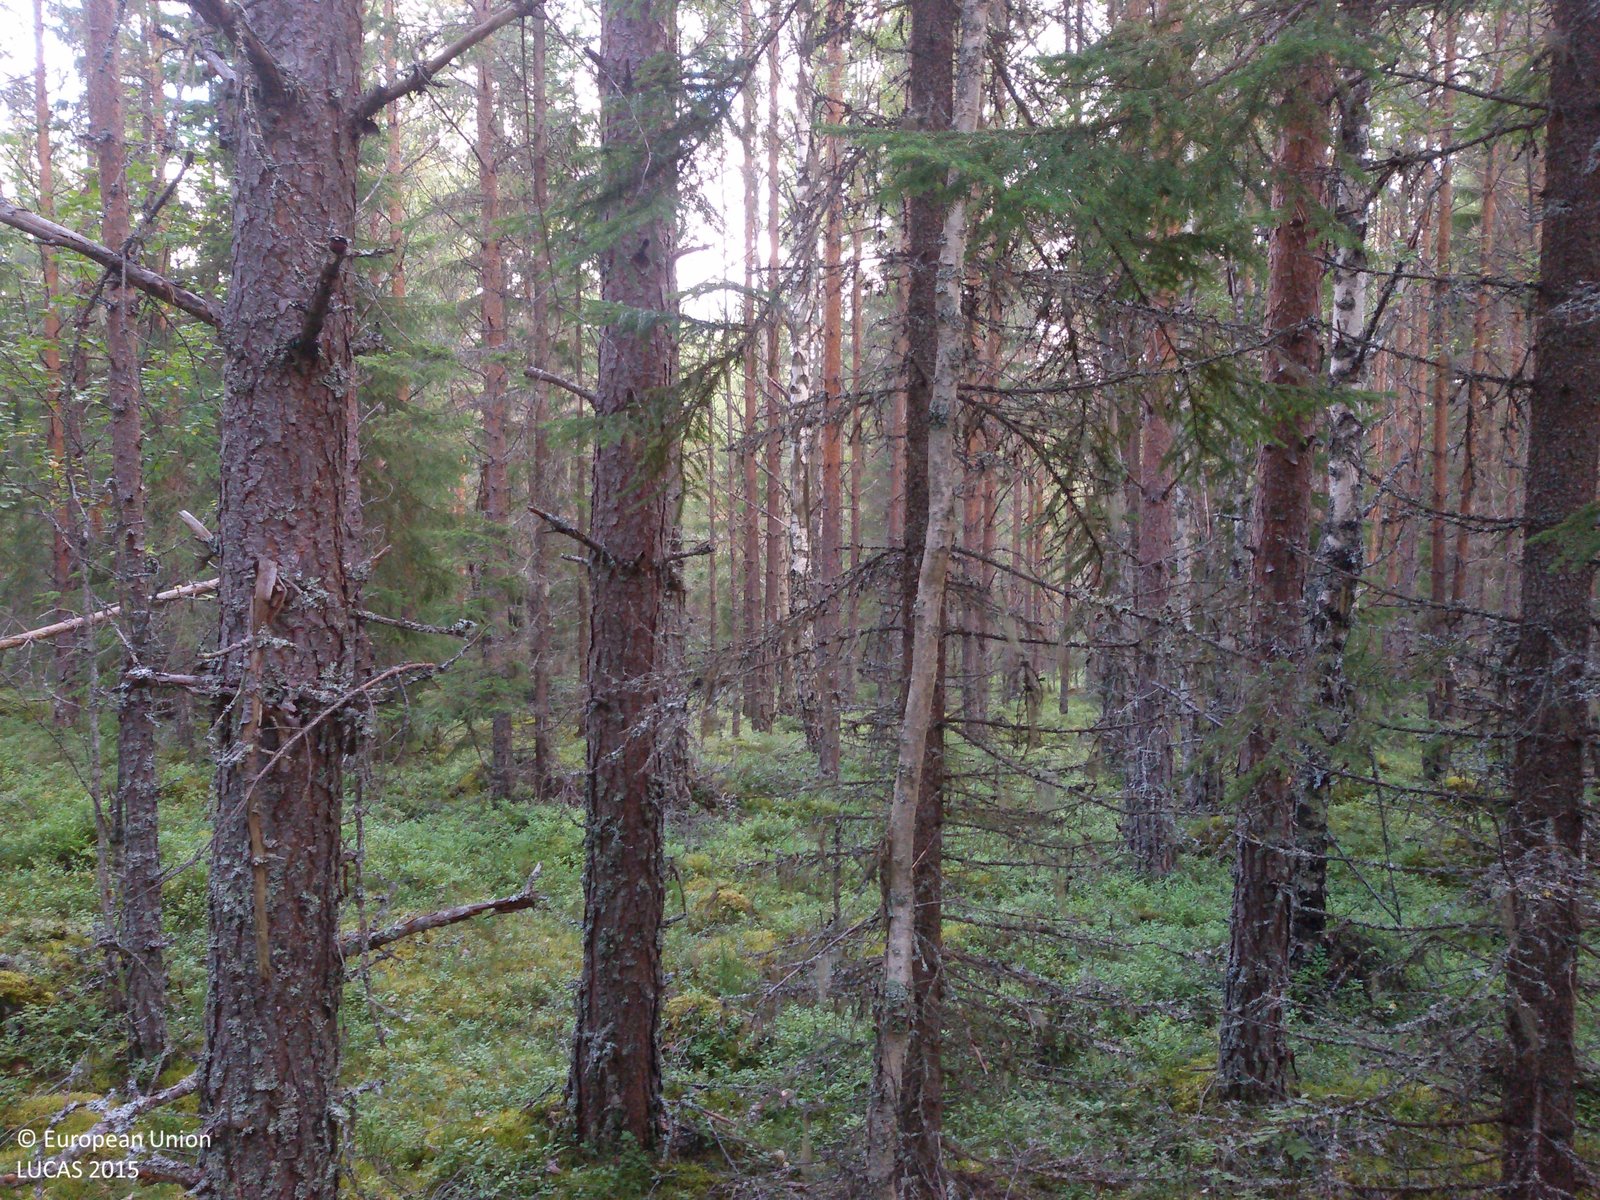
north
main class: Woodland
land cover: Pine dominated coniferous woodland
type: boreal forest
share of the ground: > 75 %
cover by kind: coniferous forest trees 80 %, shrubs 15 %, lichens and mosses 5 %
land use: Forestry
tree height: > 5 m
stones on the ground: 25 - 50 %
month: August
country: SE
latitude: 61.0181
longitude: 15.8137
